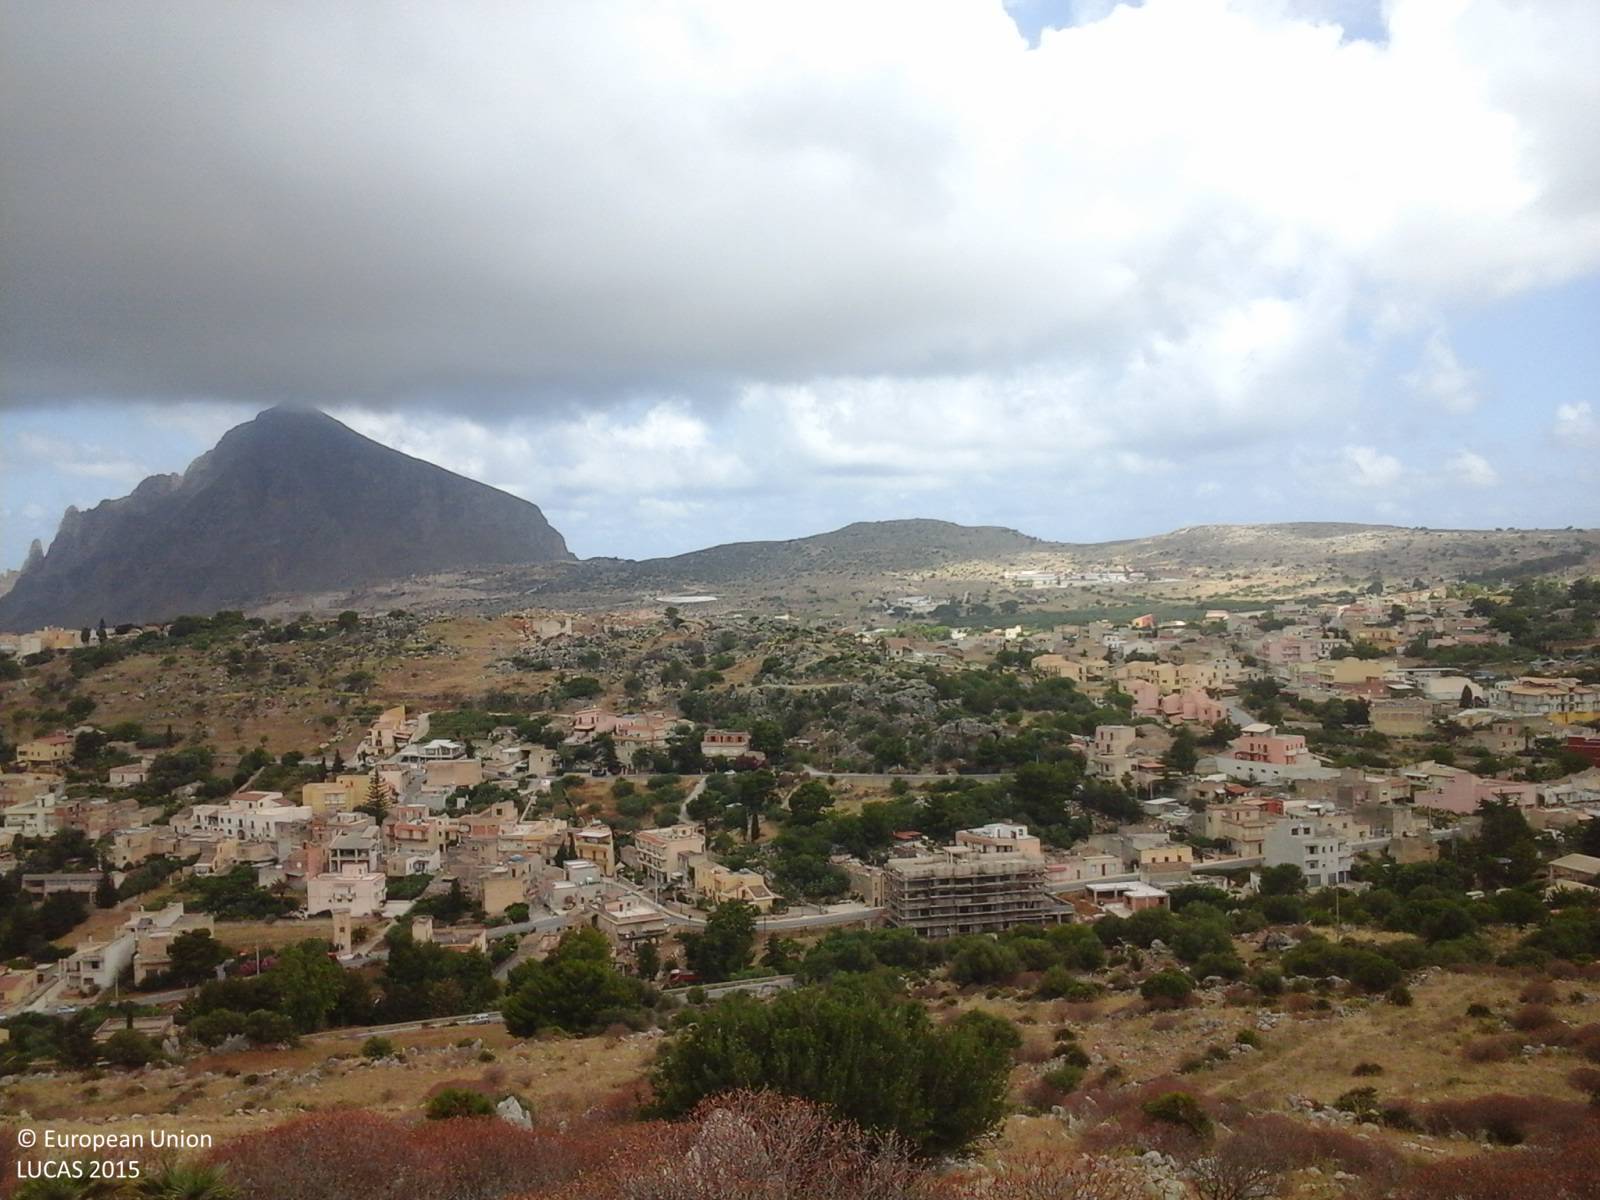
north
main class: Grassland
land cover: Grassland with sparse tree/shrub cover
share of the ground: > 75 %
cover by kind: herbaceous plants 55 %, consolidated bare surface 30 %, shrubs 10 %, coniferous forest trees 5 %
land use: Semi-natural and natural areas not in use
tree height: < 5 m
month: June
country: IT
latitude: 38.0729
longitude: 12.6824
